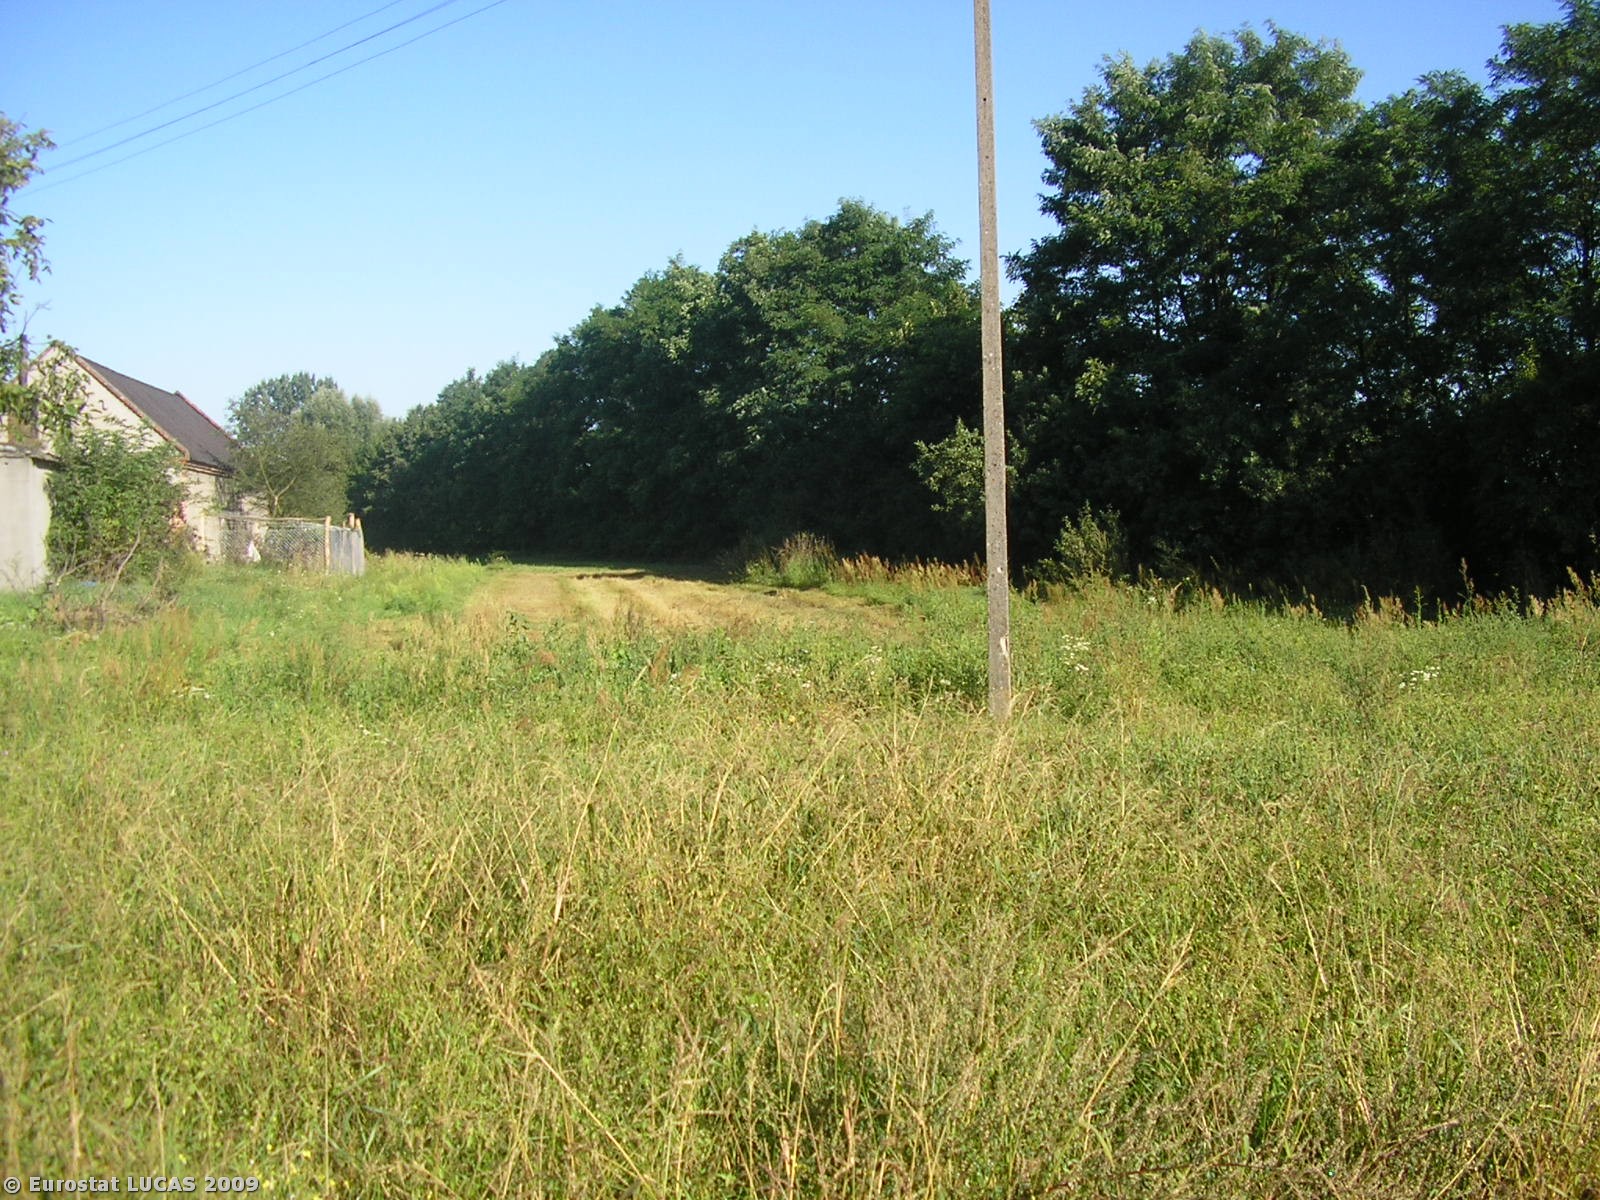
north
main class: Cropland
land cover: Potatoes
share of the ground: 25 - 50 %
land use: Agriculture (excluding fallow land and kitchen gardens)
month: September
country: PL
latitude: 51.9617
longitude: 19.4727
